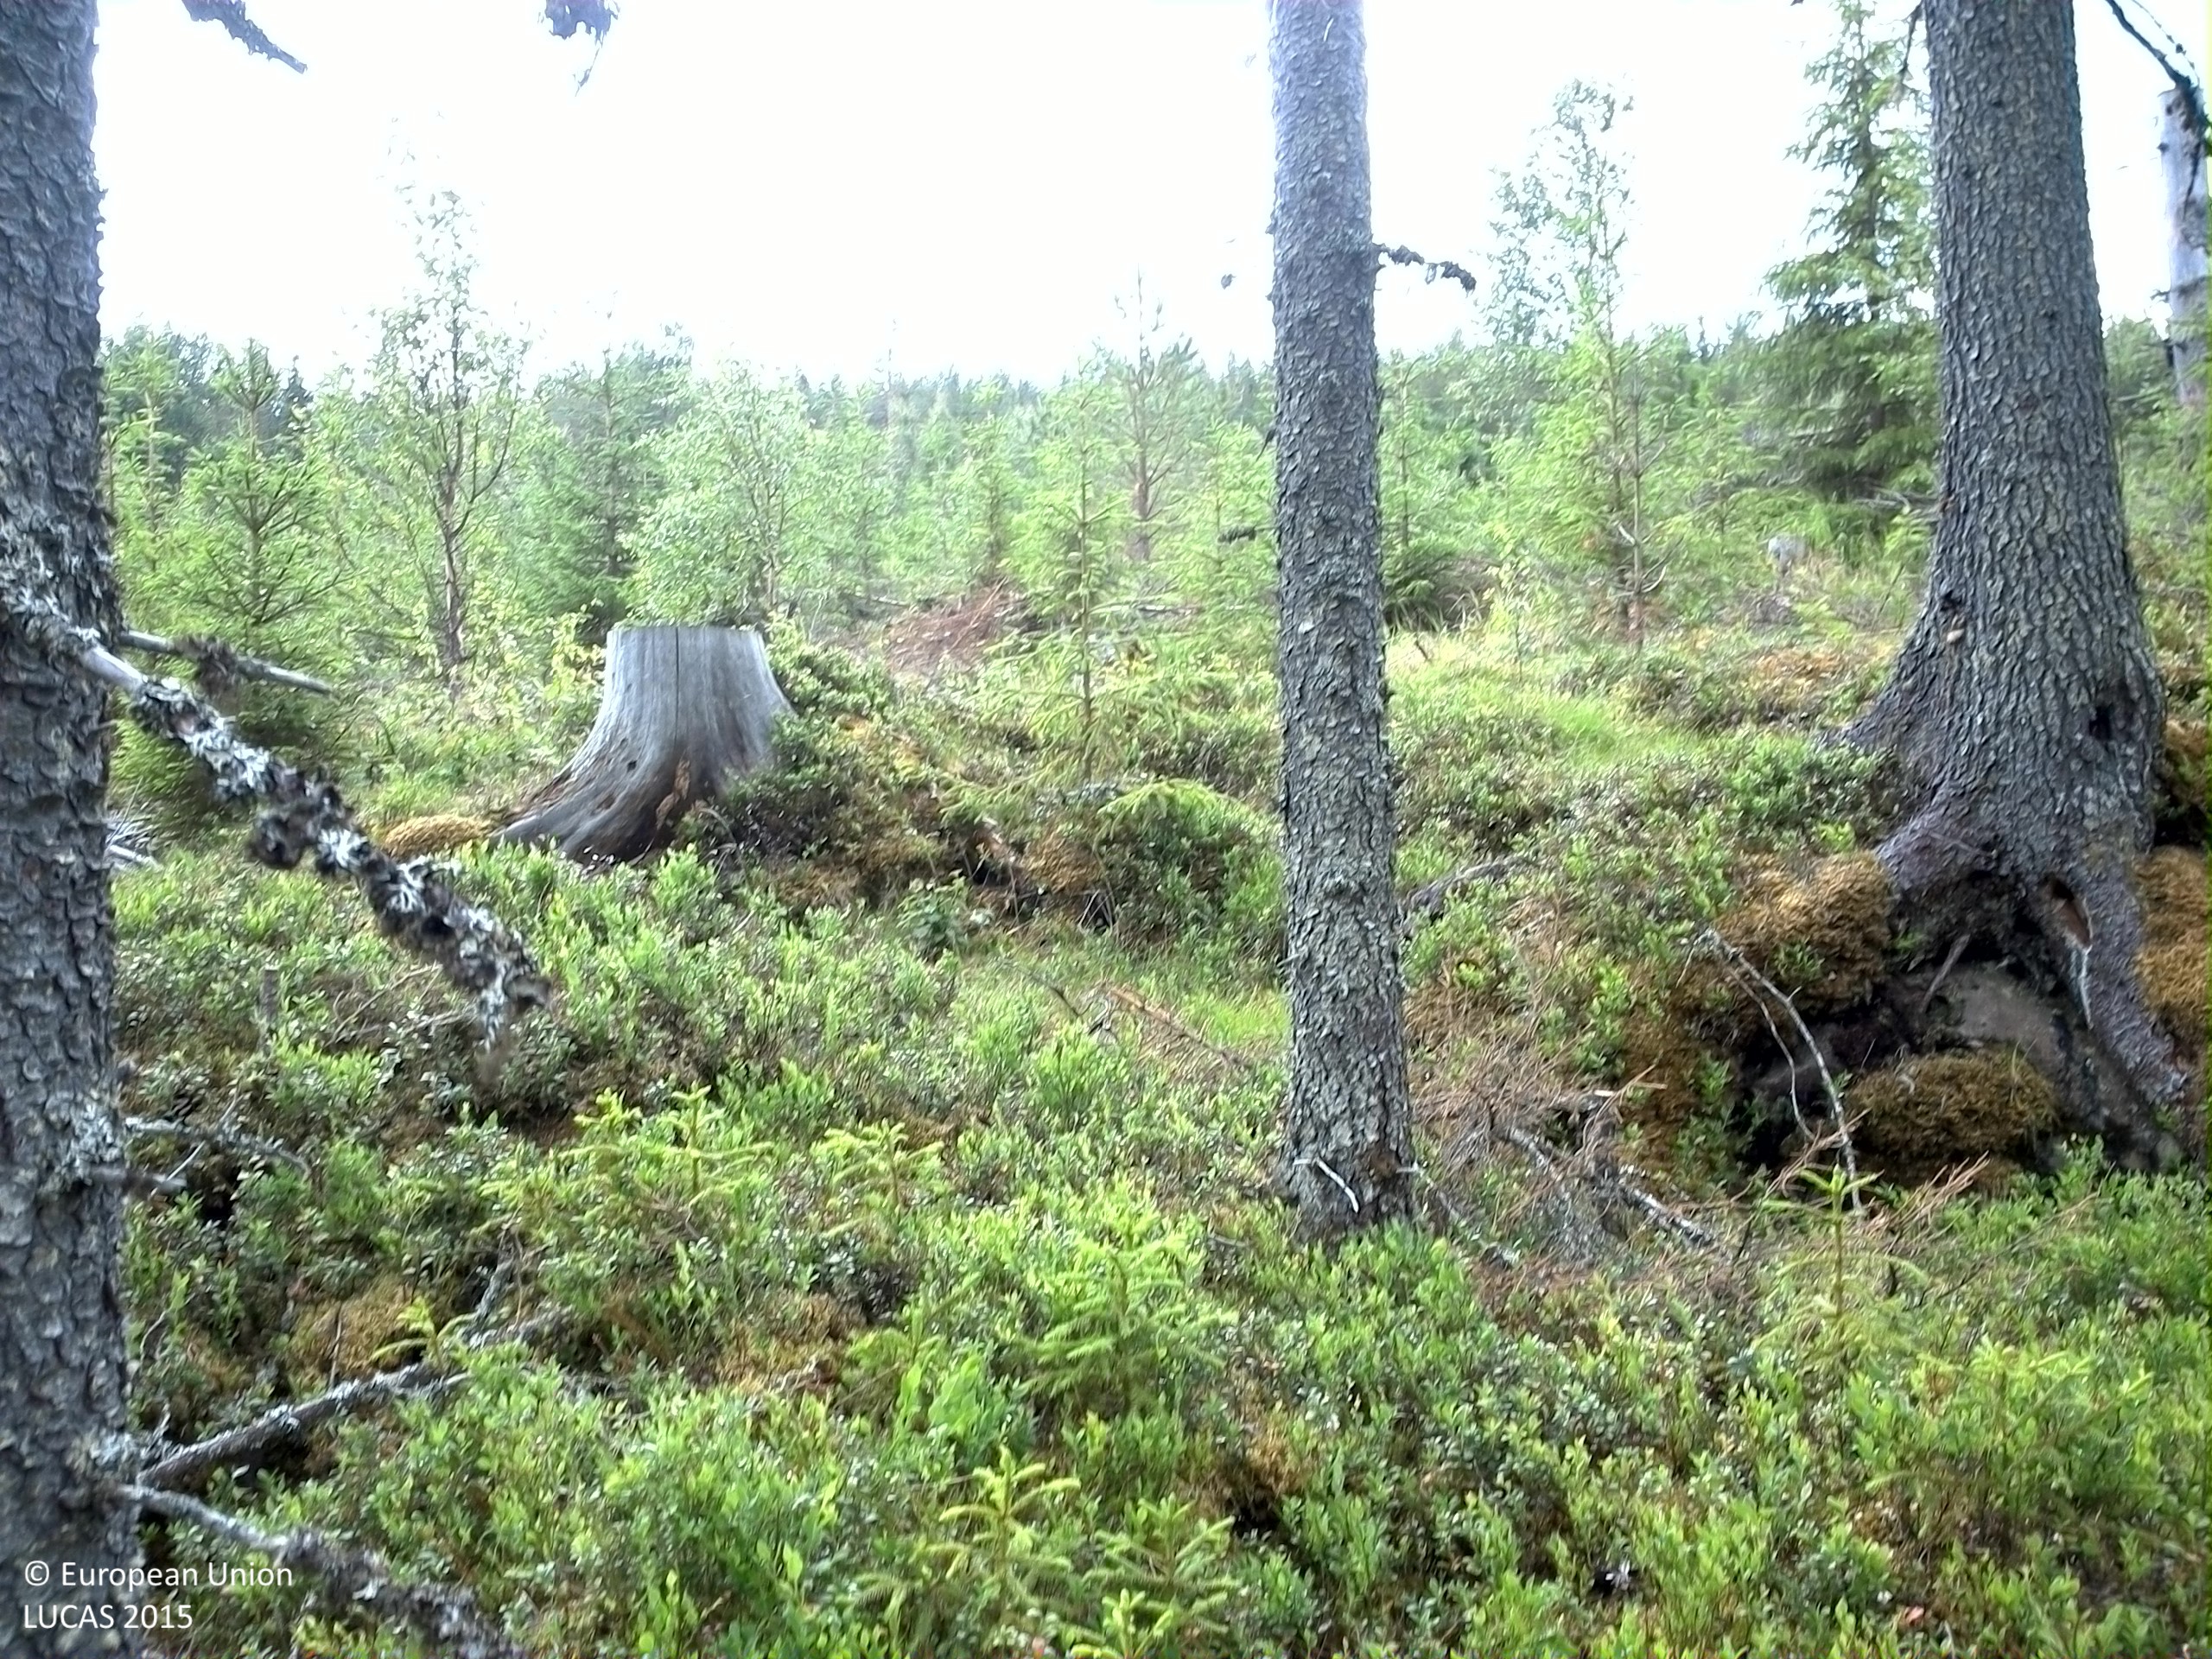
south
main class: Woodland
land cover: Spruce dominated coniferous woodland
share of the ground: 25 - 50 %
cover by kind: coniferous forest trees 30 %, shrubs 30 %, lichens and mosses 20 %, herbaceous plants 15 %, broadleaved forest trees 5 %
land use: Forestry
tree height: > 5 m
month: July
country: SE
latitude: 63.5214
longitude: 18.3986
